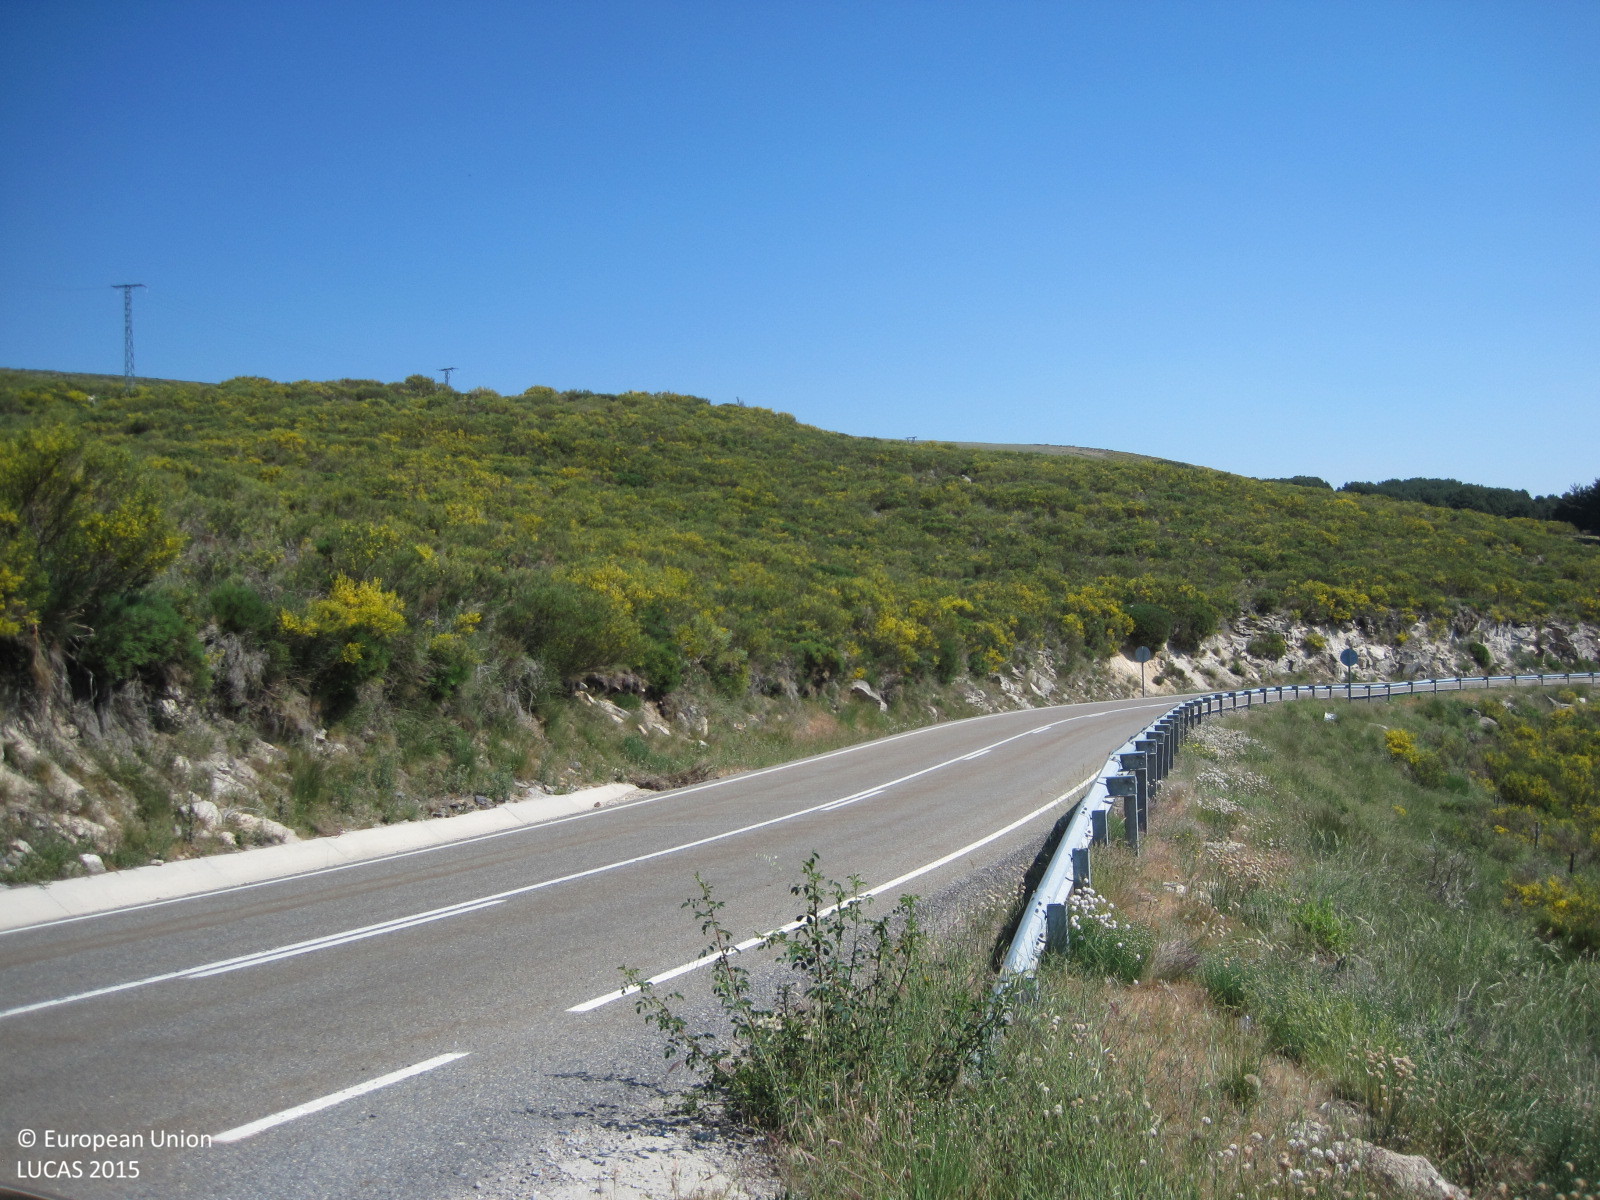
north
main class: Woodland
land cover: Pine dominated coniferous woodland
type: coniferous forest of the mediterranean region
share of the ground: 50 - 75 %
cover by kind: coniferous forest trees 45 %, consolidated bare surface 20 %, unconsolidated bare surface 20 %, herbaceous plants 10 %
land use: Semi-natural and natural areas not in use
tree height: > 5 m
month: June
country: ES
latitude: 40.3273
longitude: -5.0633
